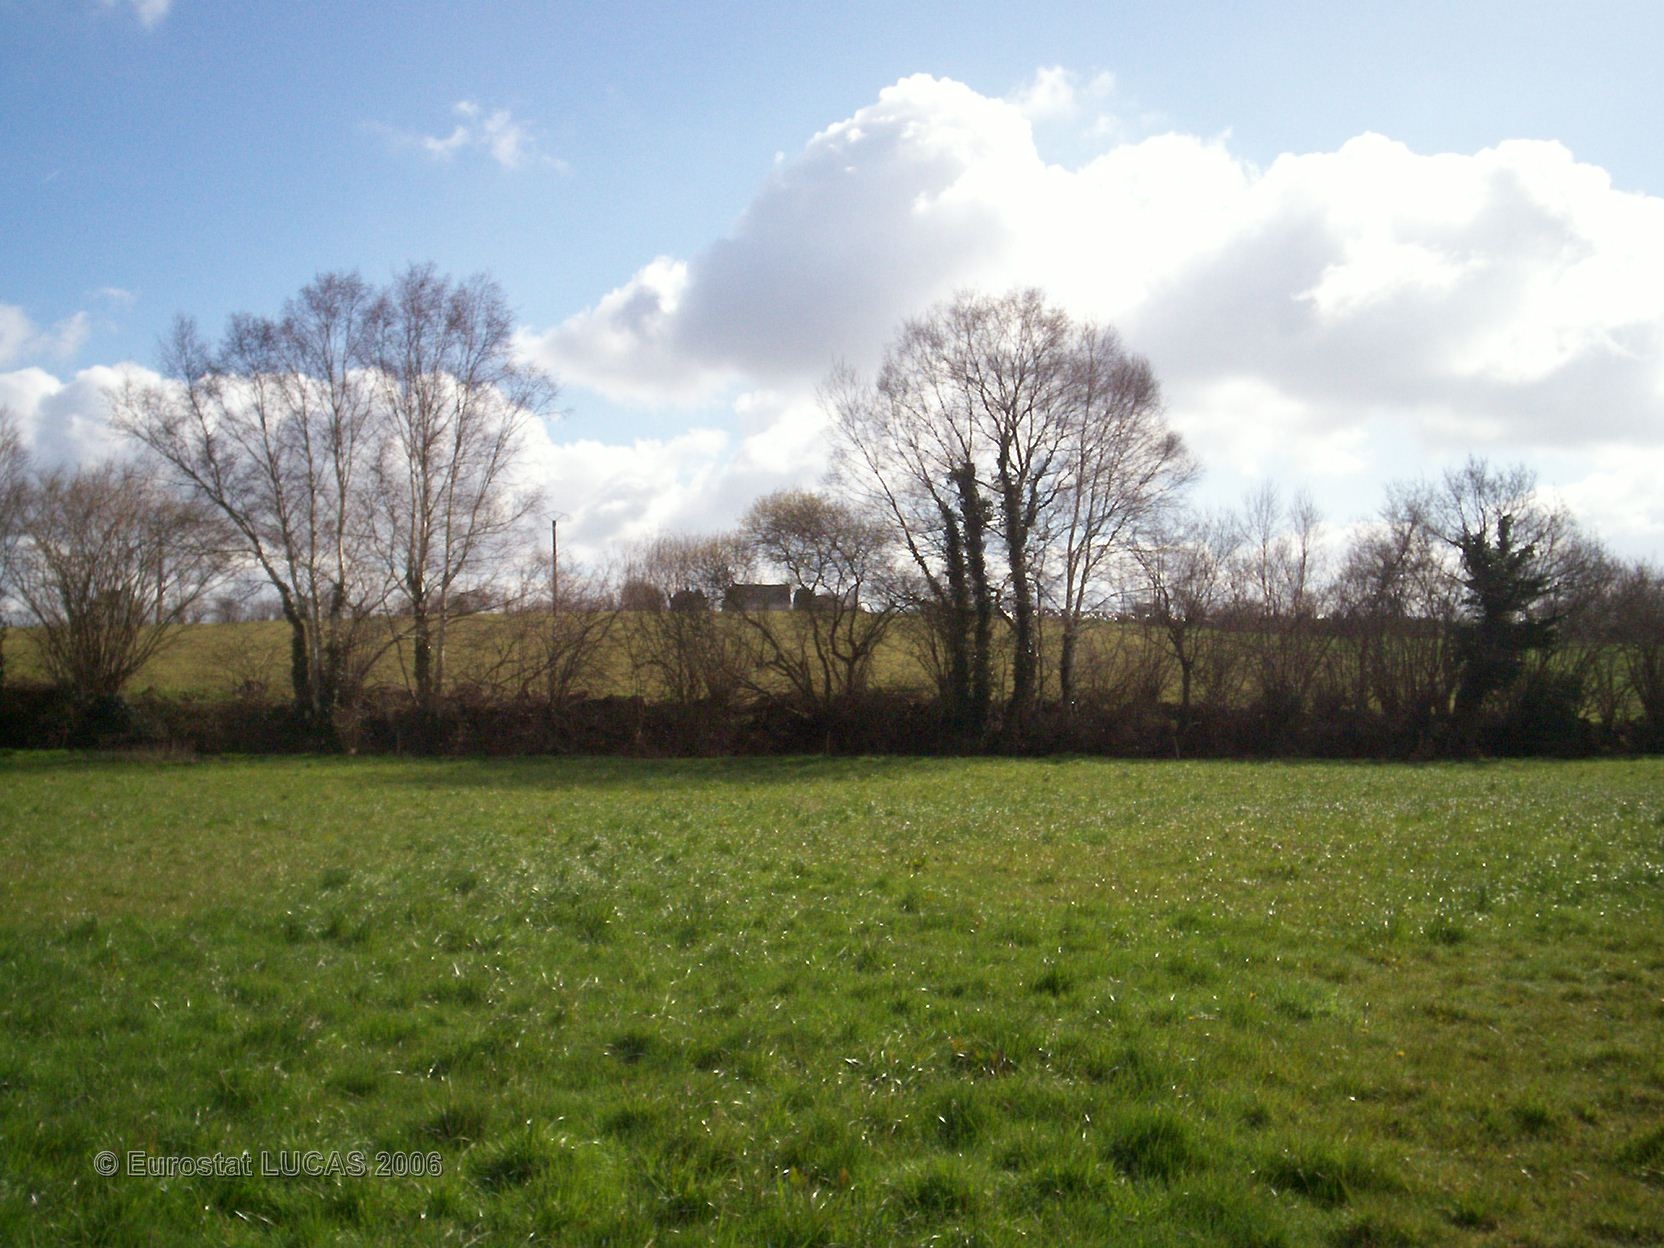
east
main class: Grassland
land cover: Grassland without tree/shrub cover
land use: Agriculture (excluding fallow land and kitchen gardens)
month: April
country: FR
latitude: 48.1340
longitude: -3.6656
